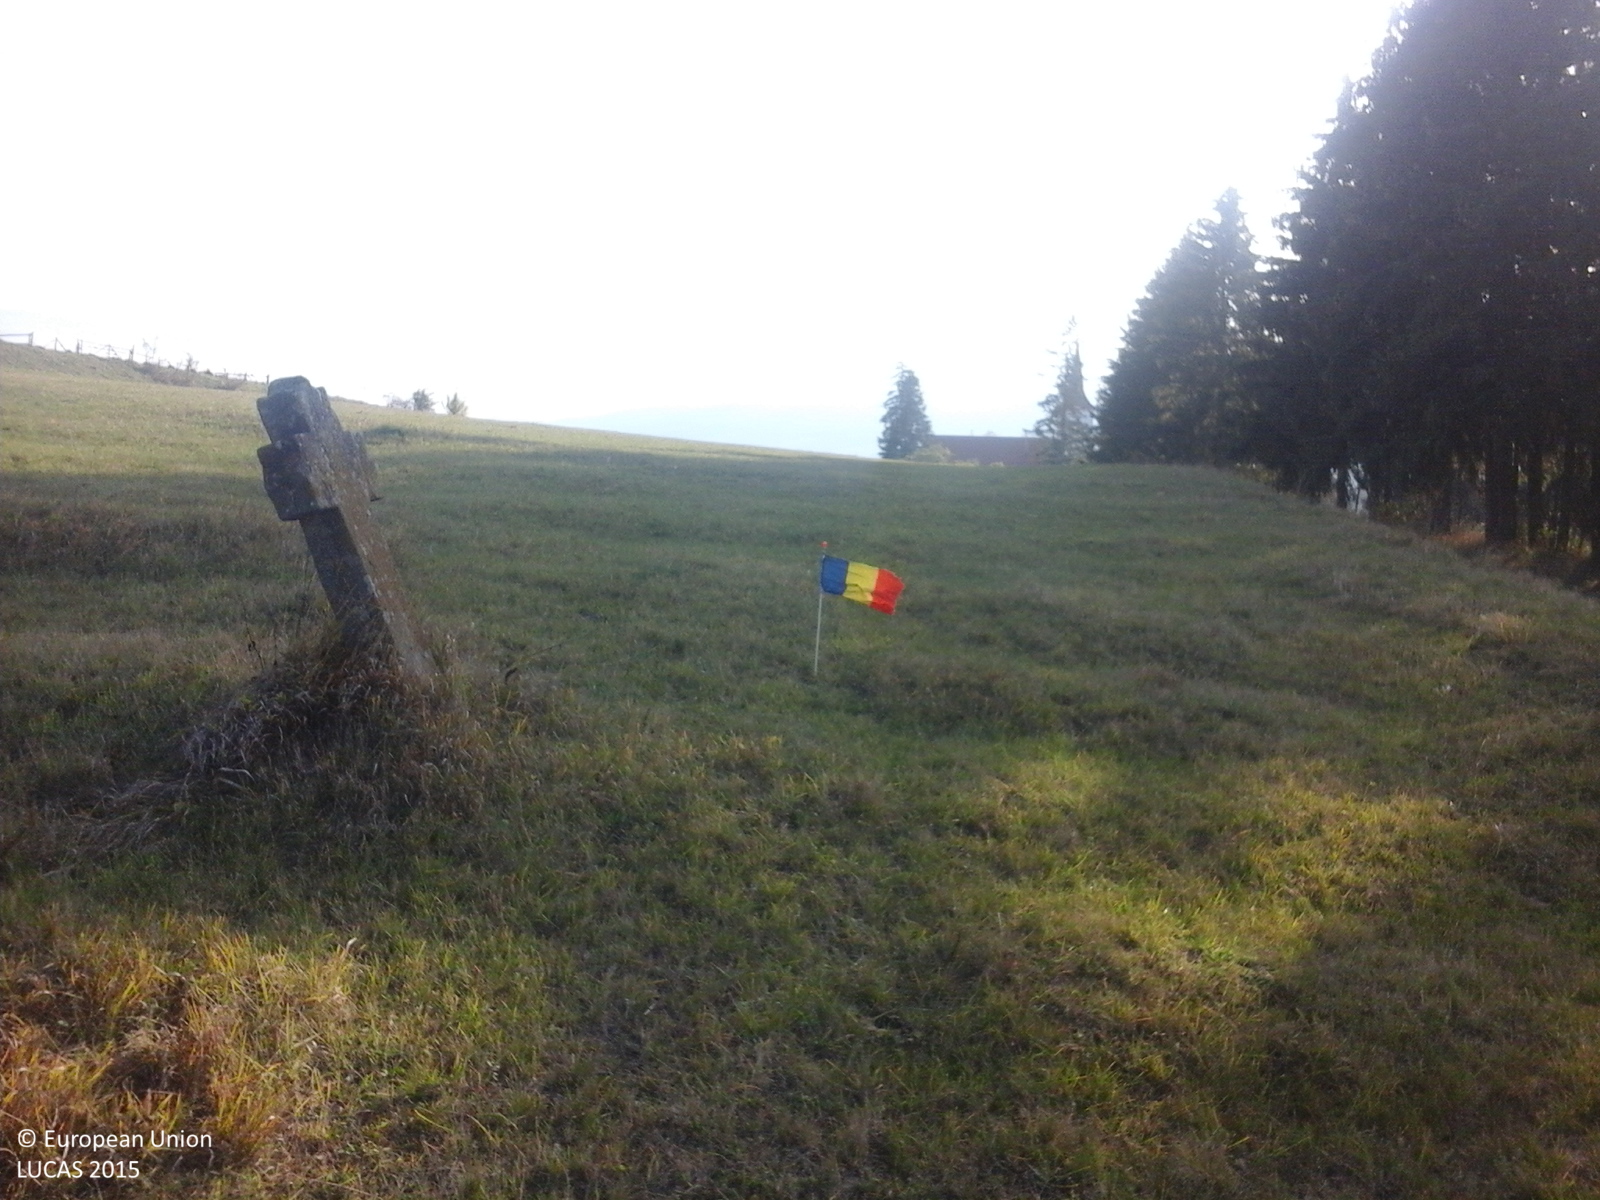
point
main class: Grassland
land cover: Grassland without tree/shrub cover
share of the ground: > 75 %
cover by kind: herbaceous plants 100 %
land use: Agriculture (excluding fallow land and kitchen gardens)
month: October
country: RO
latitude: 46.3516
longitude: 25.8531
